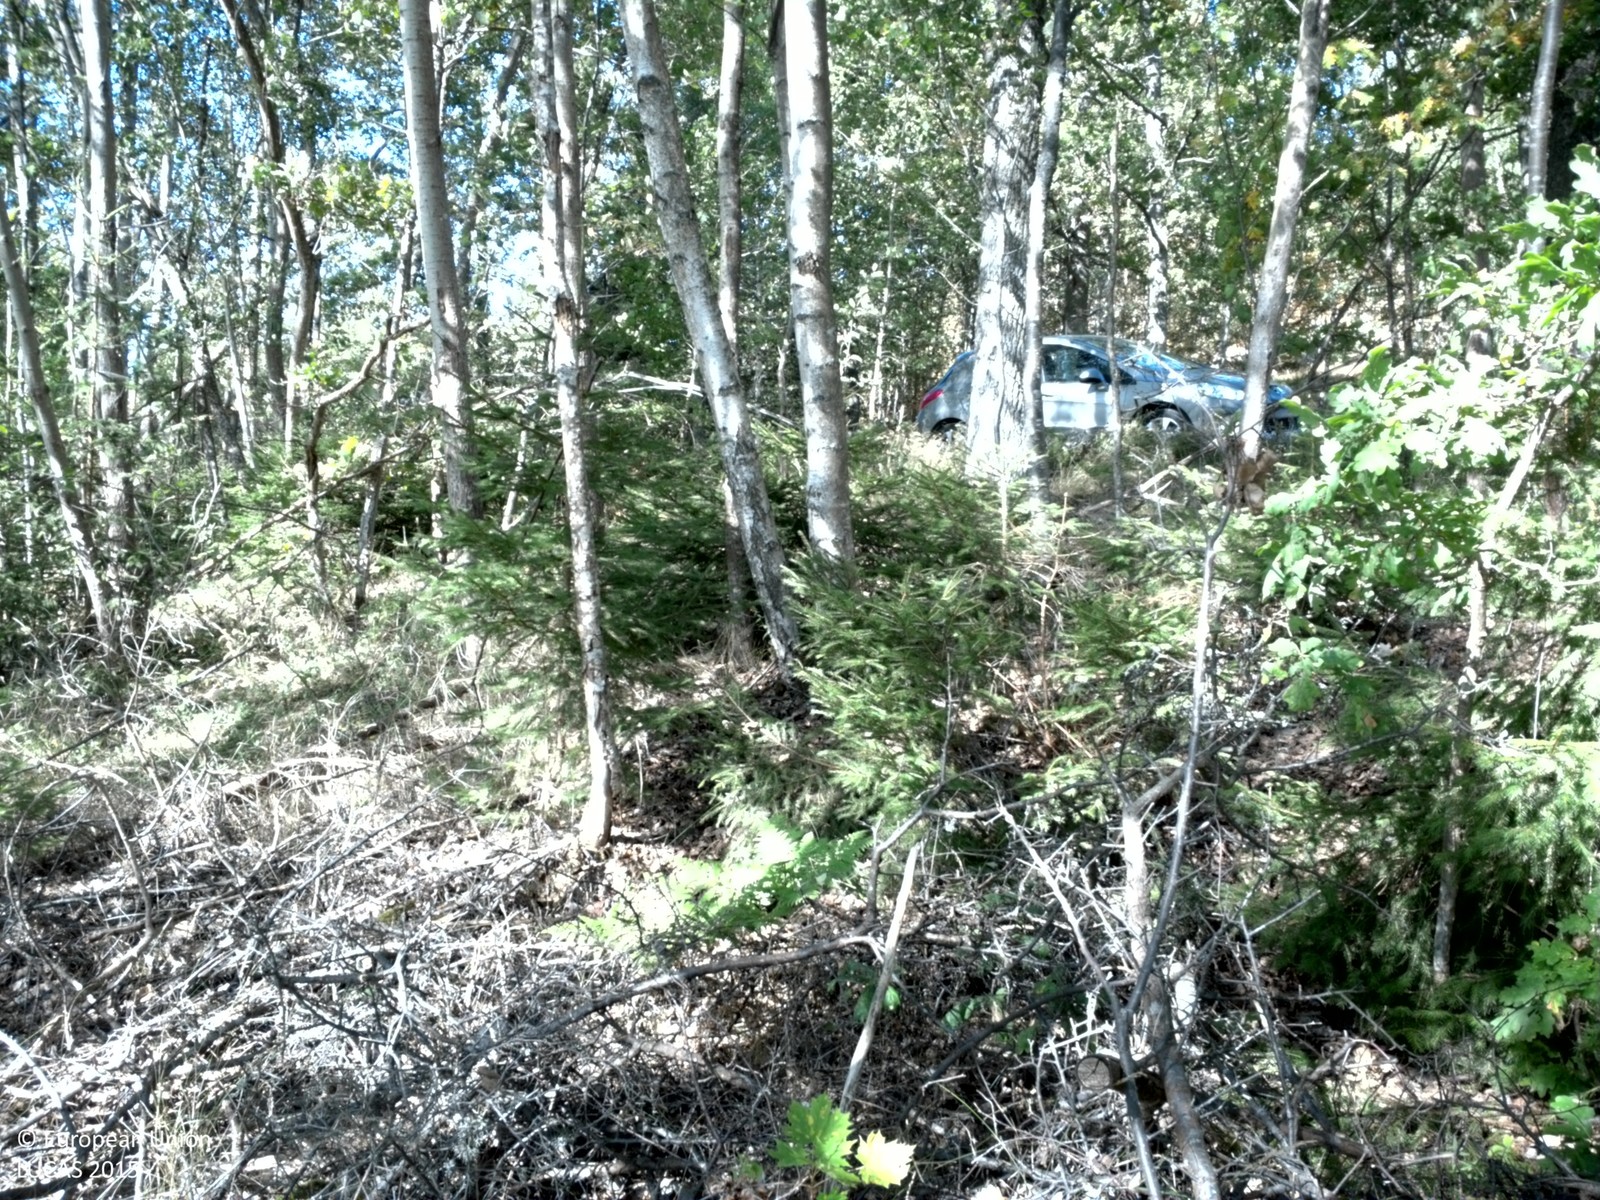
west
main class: Woodland
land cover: Broadleaved woodland
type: hemiboreal forest and nemoral coniferous forest and mixed broadleaved-coniferous forest
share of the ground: 50 - 75 %
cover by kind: broadleaved forest trees 65 %, herbaceous plants 30 %, coniferous forest trees 5 %
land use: Forestry
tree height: > 5 m
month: August
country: SE
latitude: 59.4689
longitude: 17.6023
